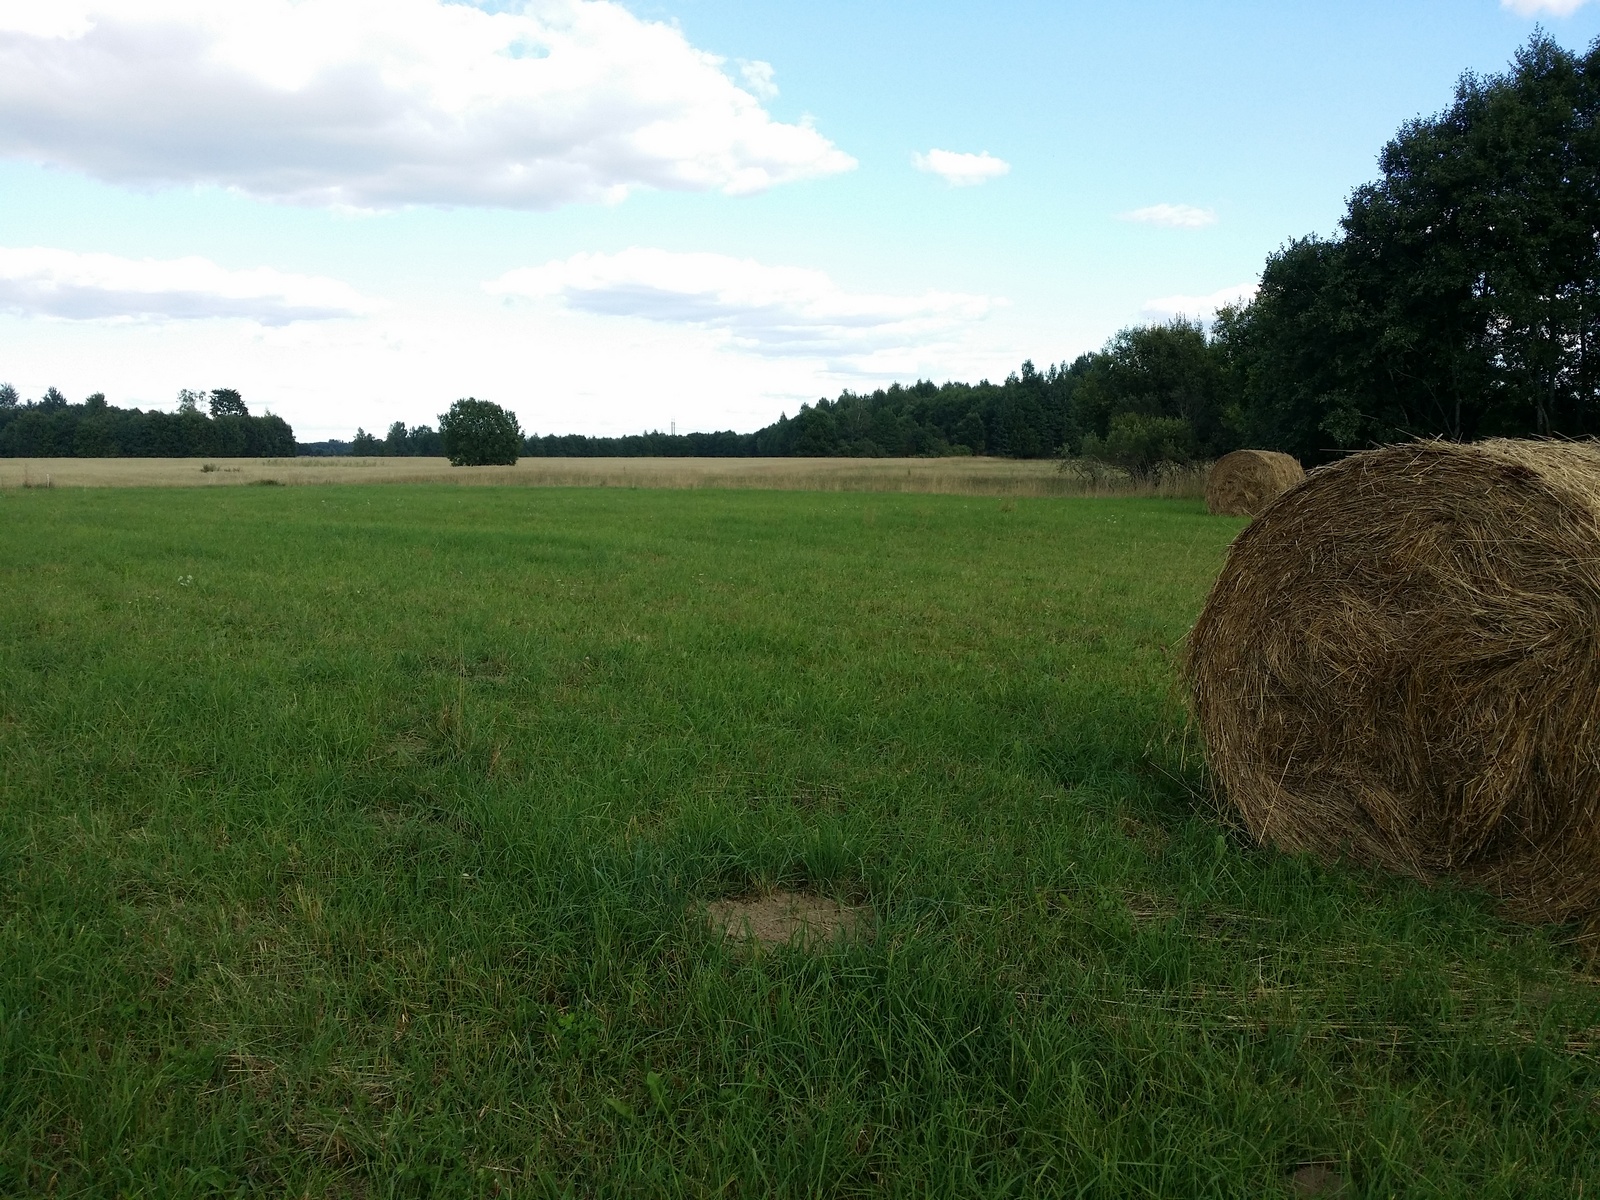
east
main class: Grassland
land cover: Grassland without tree/shrub cover
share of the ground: > 75 %
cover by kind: herbaceous plants 85 %, unconsolidated bare surface 15 %
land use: Agriculture (excluding fallow land and kitchen gardens)
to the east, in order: Grassland without tree/shrub cover; Triticale; Single bushes/trees; Triticale
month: August
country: LV
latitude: 56.9562
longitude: 27.5596
